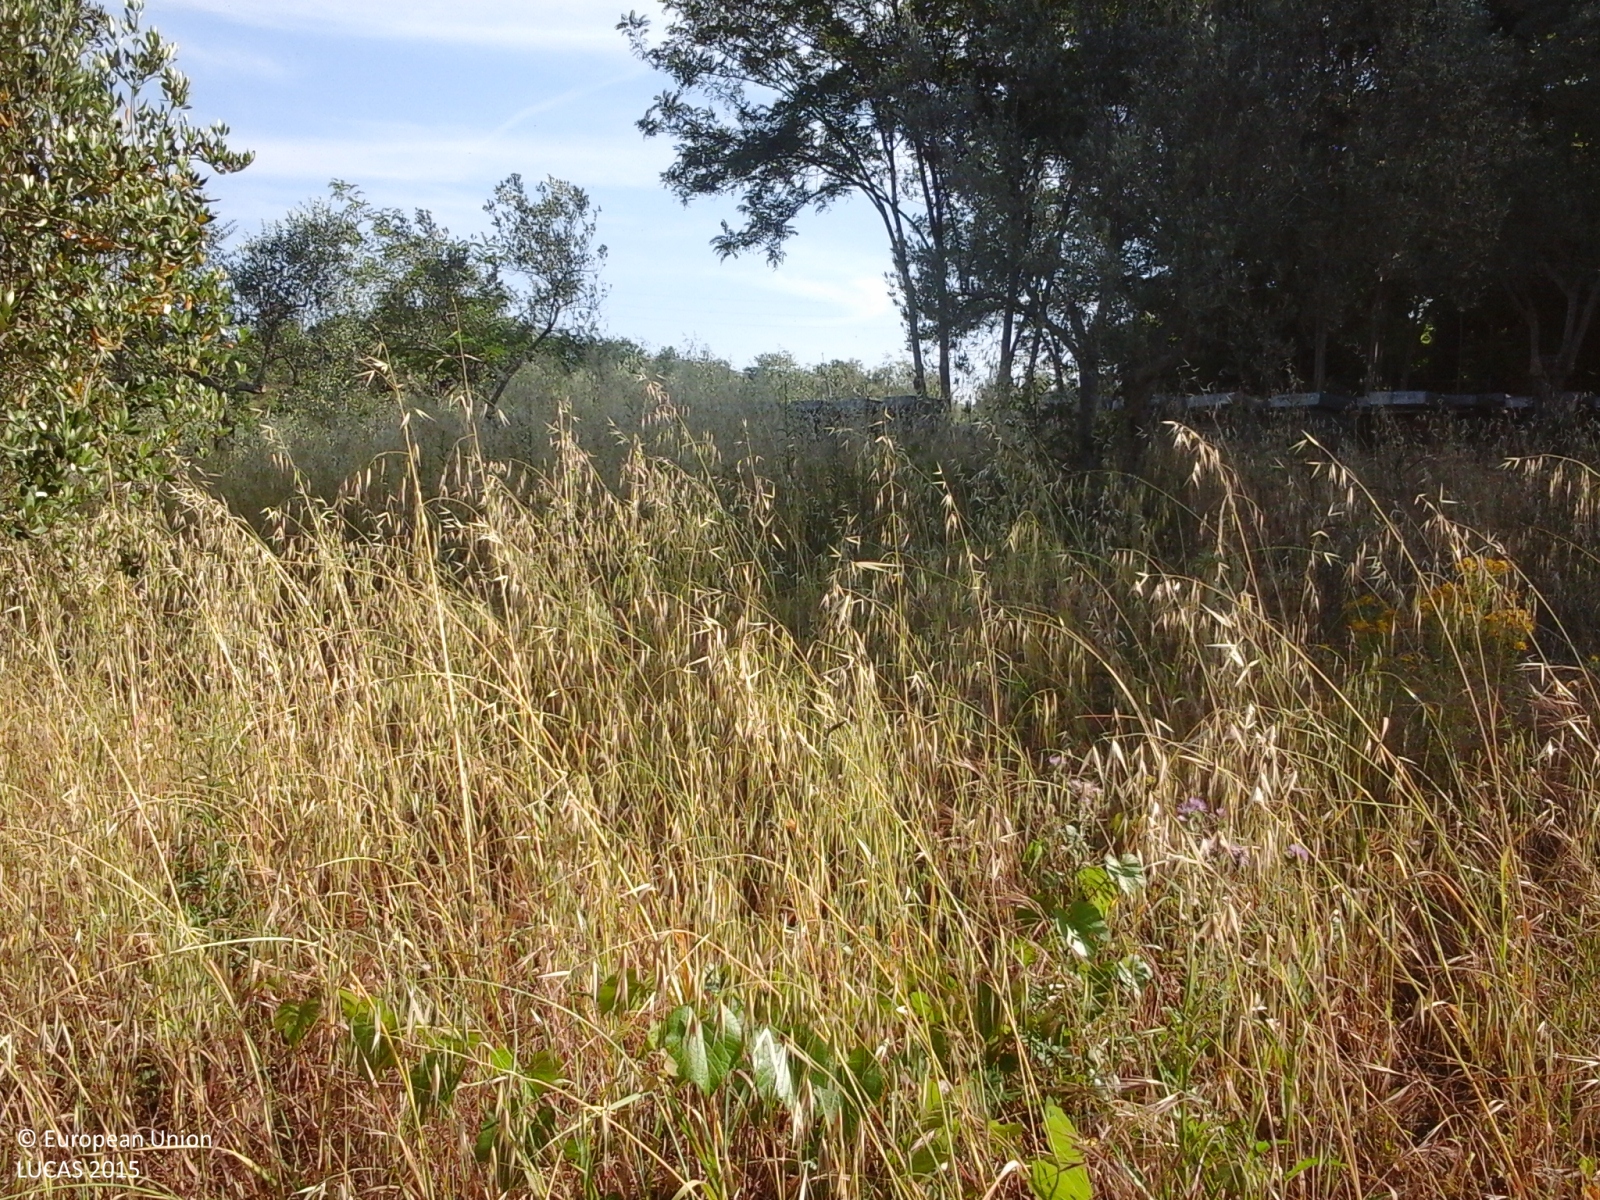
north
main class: Cropland
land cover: Olive groves
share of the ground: 25 - 50 %
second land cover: Spontaneously vegetated surfaces
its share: > 75 %
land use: Agriculture (excluding fallow land and kitchen gardens)
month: May
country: IT
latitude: 41.2048
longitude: 14.7167
